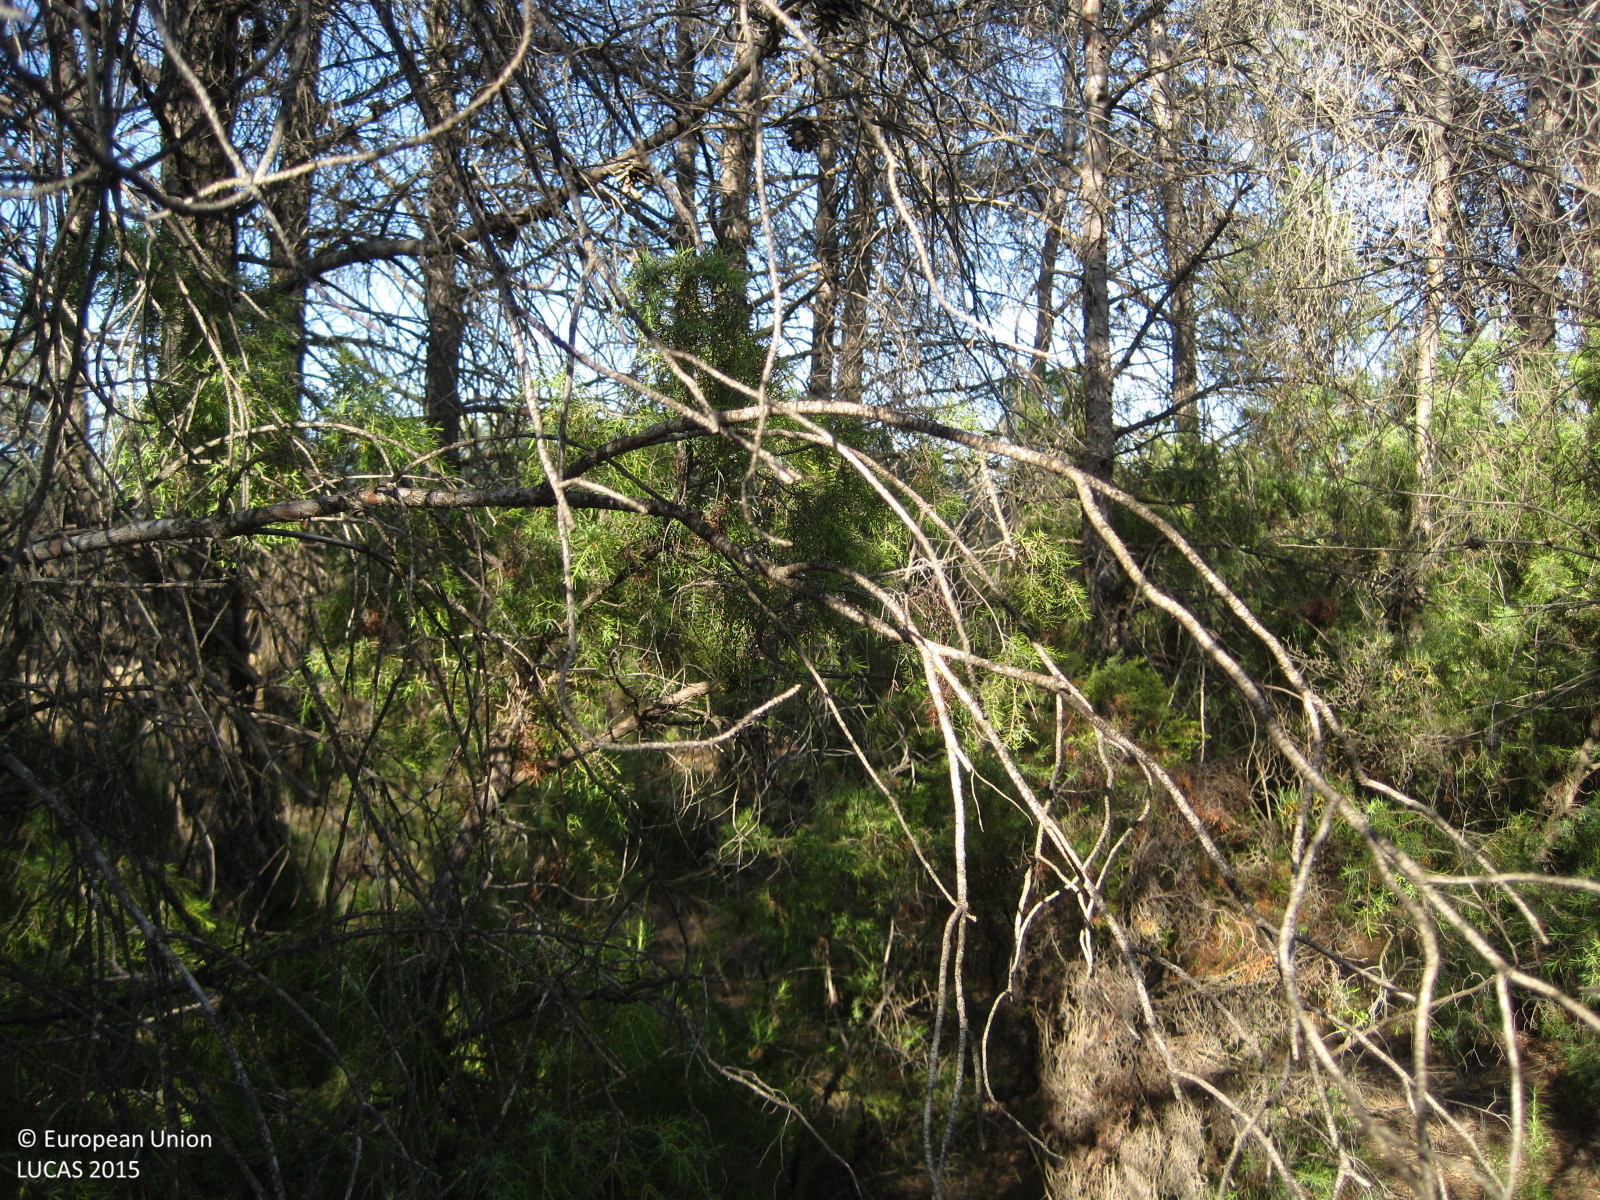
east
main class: Woodland
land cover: Pine dominated coniferous woodland
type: coniferous forest of the mediterranean region
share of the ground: > 75 %
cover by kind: coniferous forest trees 90 %, shrubs 10 %
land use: Forestry
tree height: > 5 m
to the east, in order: Pine dominated coniferous woodland; Tracks; Shrubland without tree cover; Broadleaved woodland; Pine dominated coniferous woodland; Barley
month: May
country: ES
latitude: 39.6115
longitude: -1.1497
